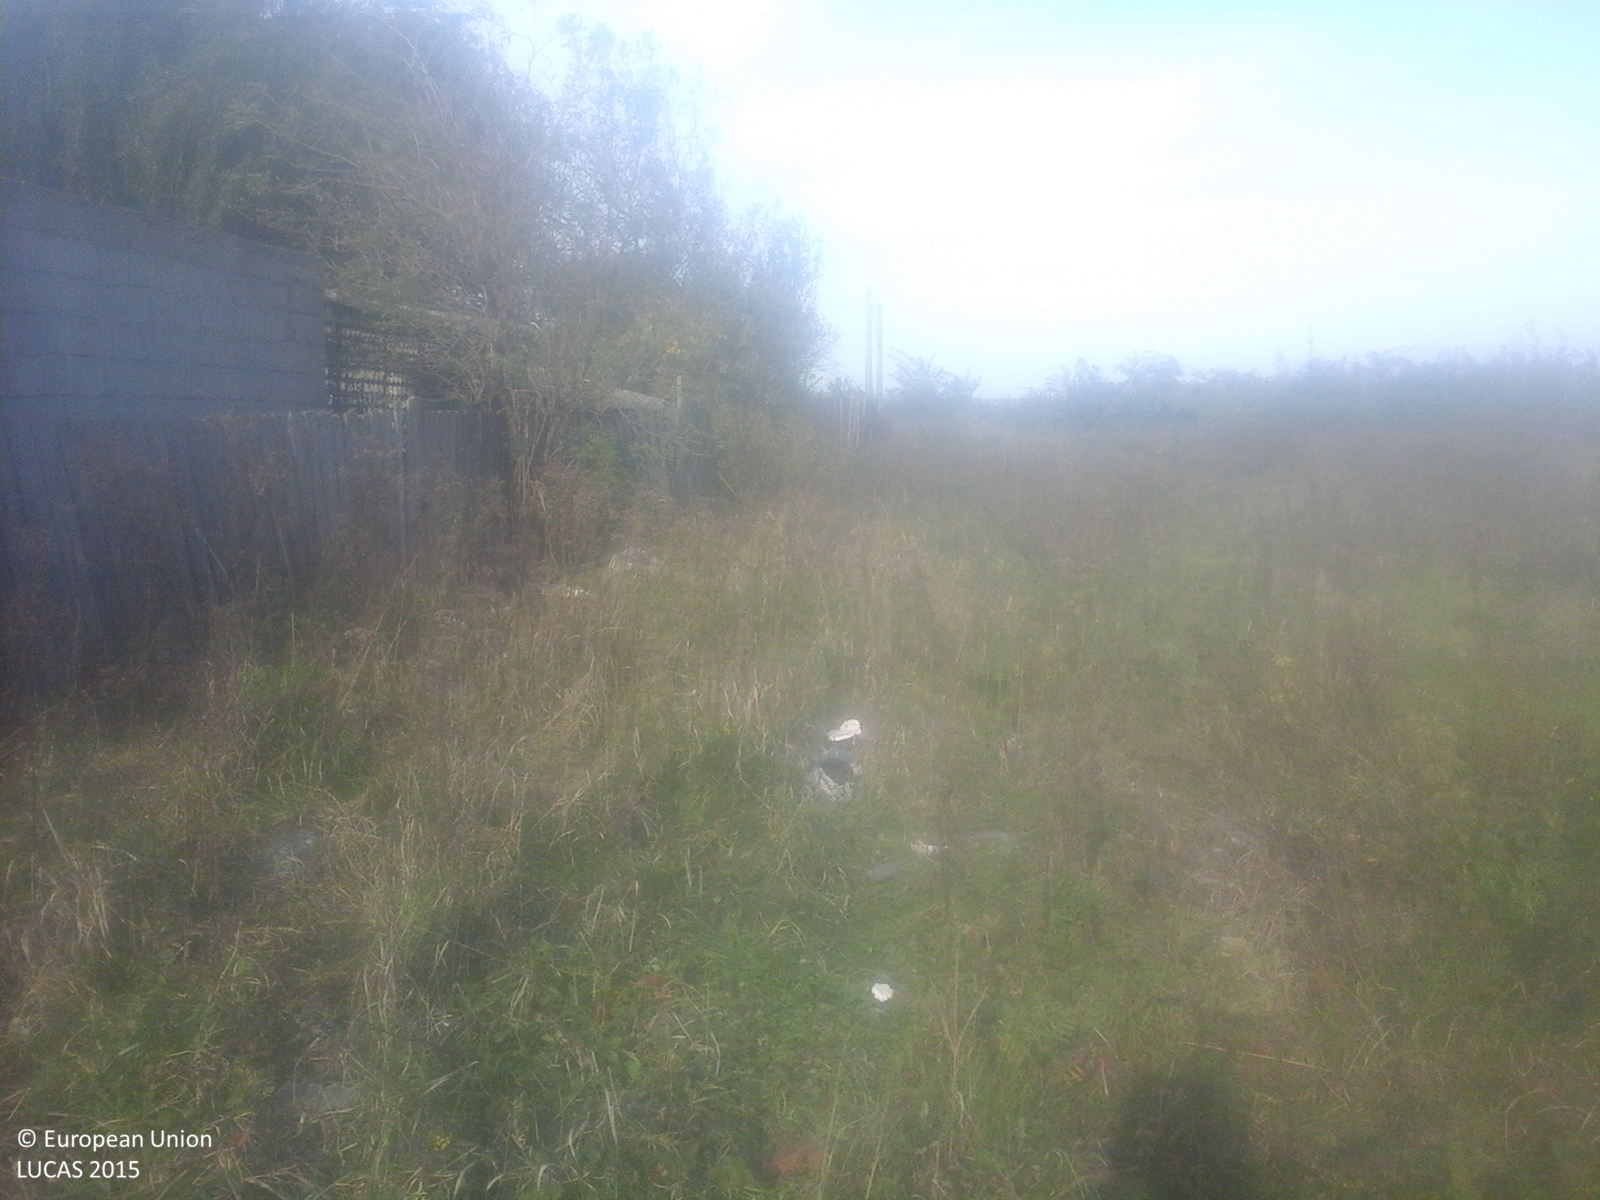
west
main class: Grassland
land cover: Grassland with sparse tree/shrub cover
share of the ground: > 75 %
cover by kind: herbaceous plants 85 %, shrubs 10 %, broadleaved forest trees 5 %
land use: Agriculture (excluding fallow land and kitchen gardens)
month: October
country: RO
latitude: 45.3901
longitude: 27.0638
